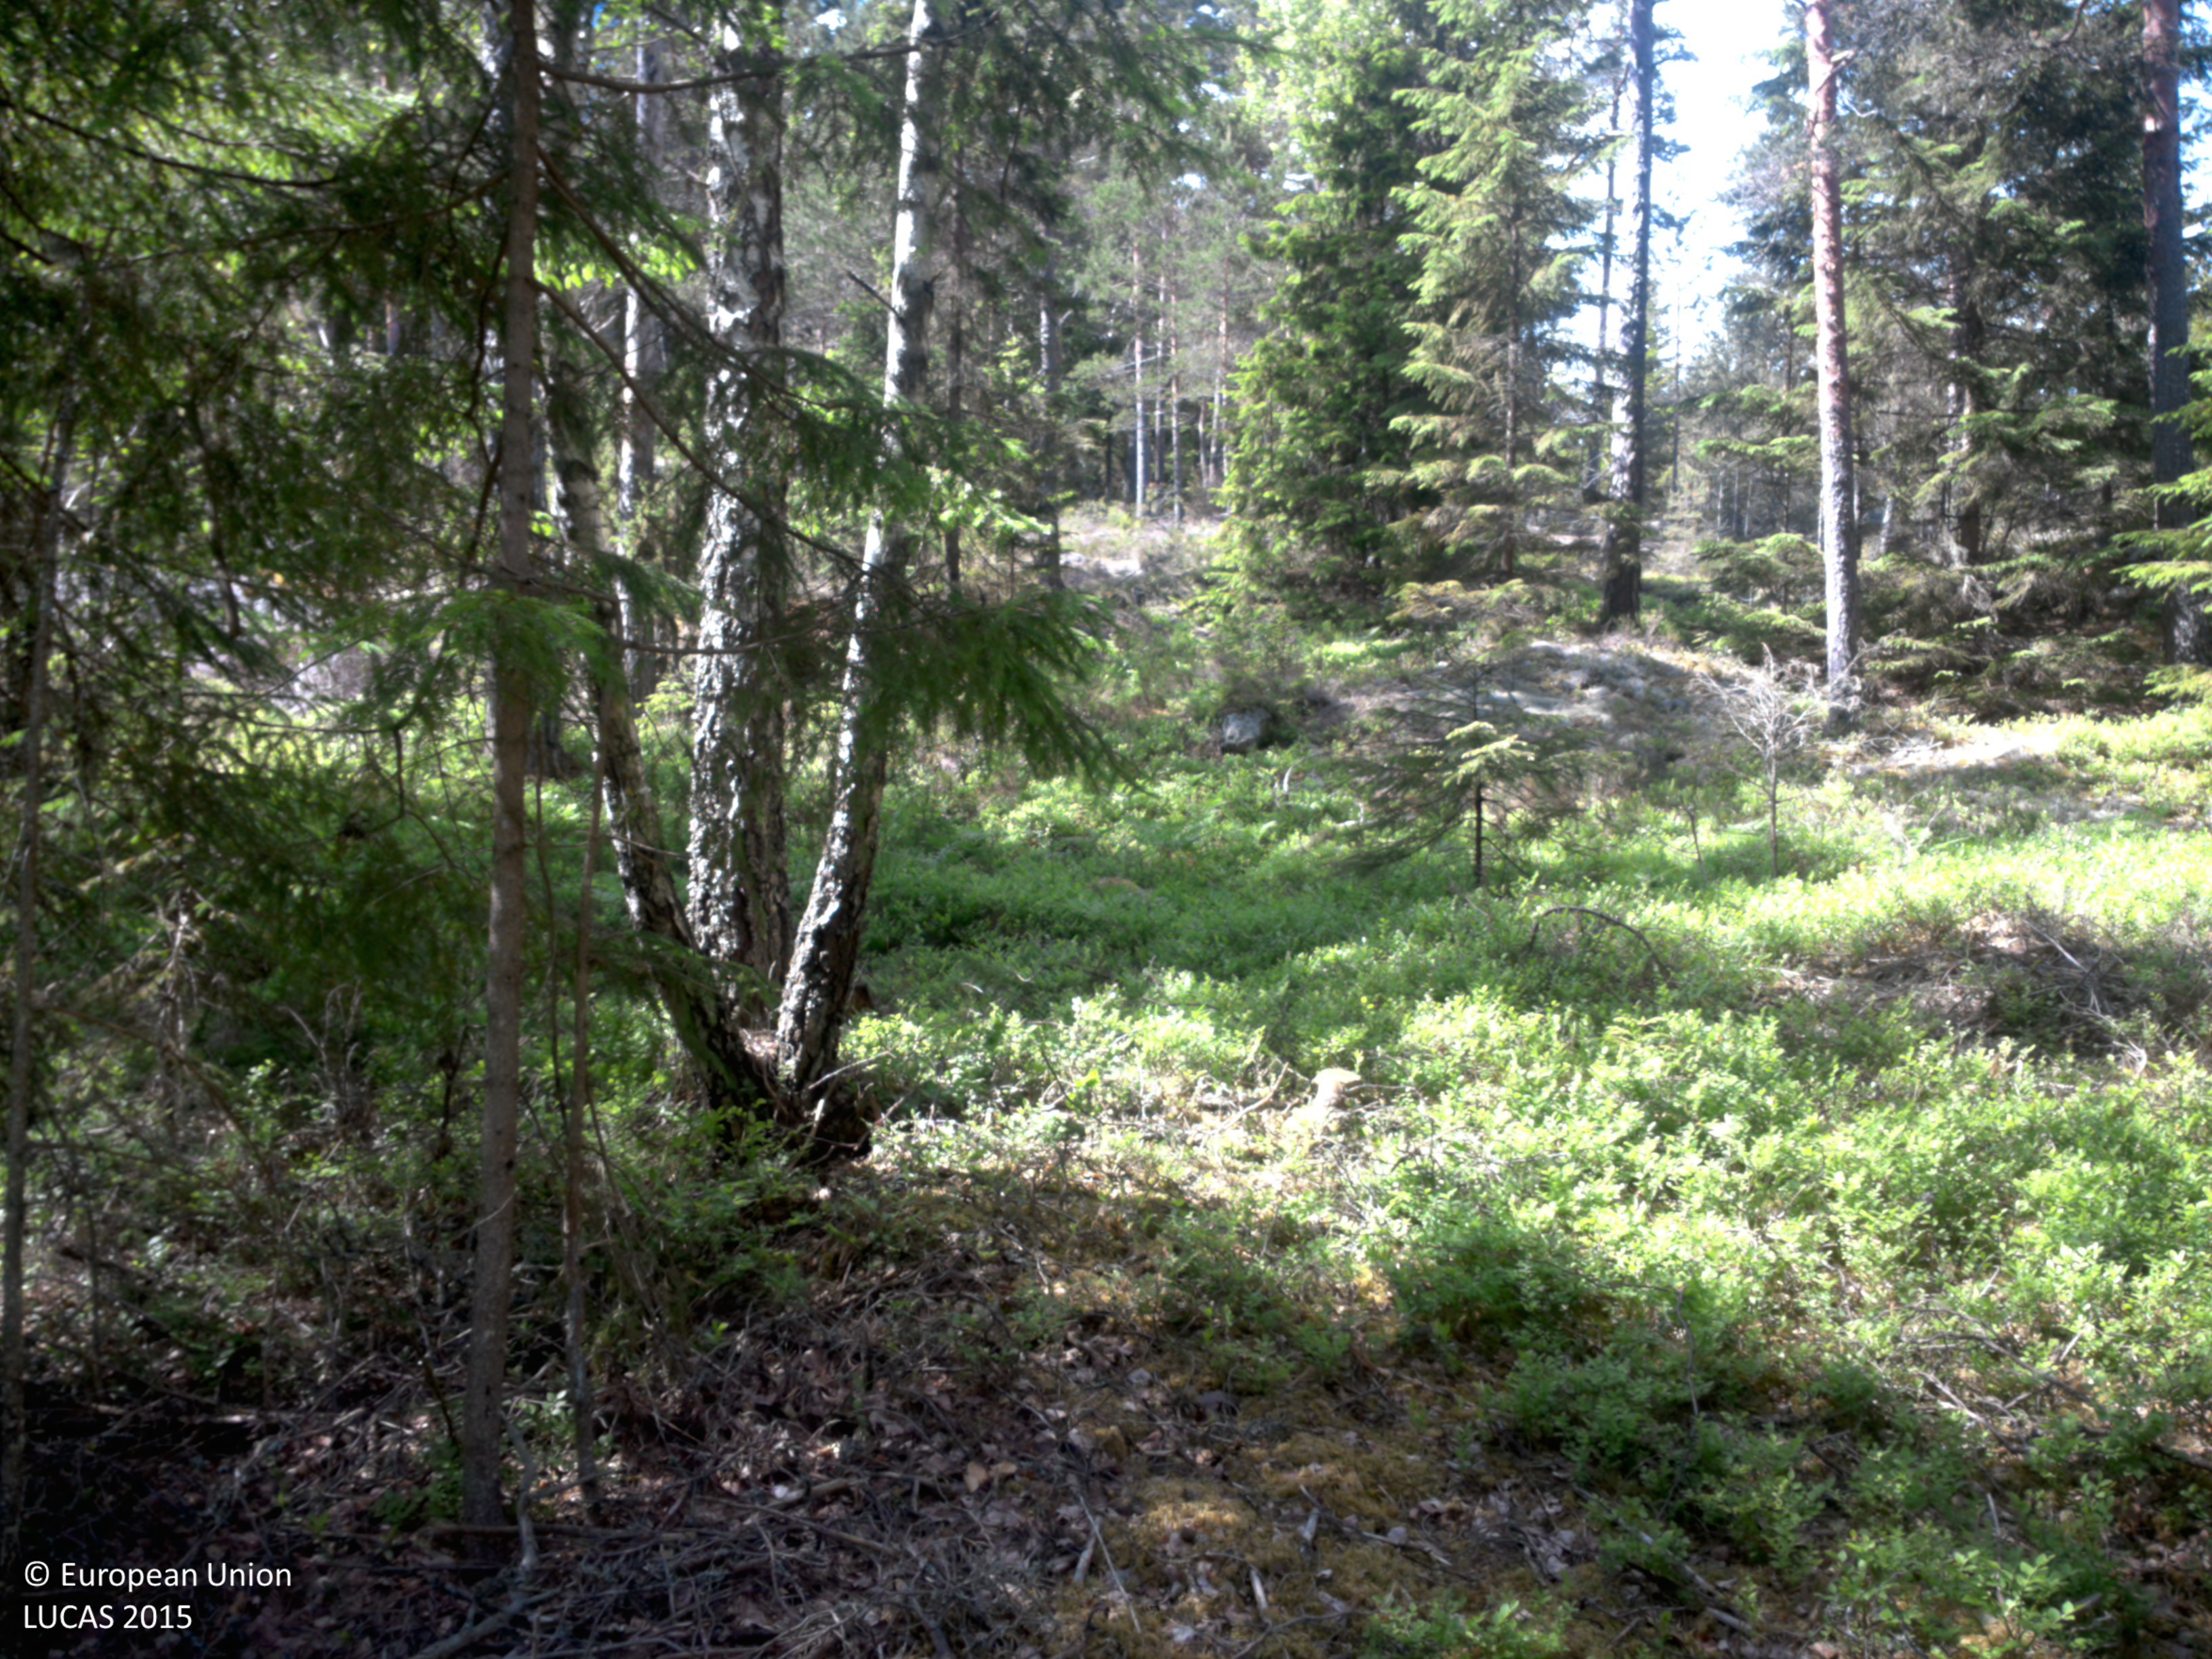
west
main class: Woodland
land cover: Other mixed woodland
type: boreal forest
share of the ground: 50 - 75 %
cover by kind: coniferous forest trees 40 %, herbaceous plants 25 %, broadleaved forest trees 15 %, shrubs 15 %, lichens and mosses 5 %
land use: Forestry
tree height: > 5 m
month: June
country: SE
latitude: 59.0528
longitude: 11.8262
